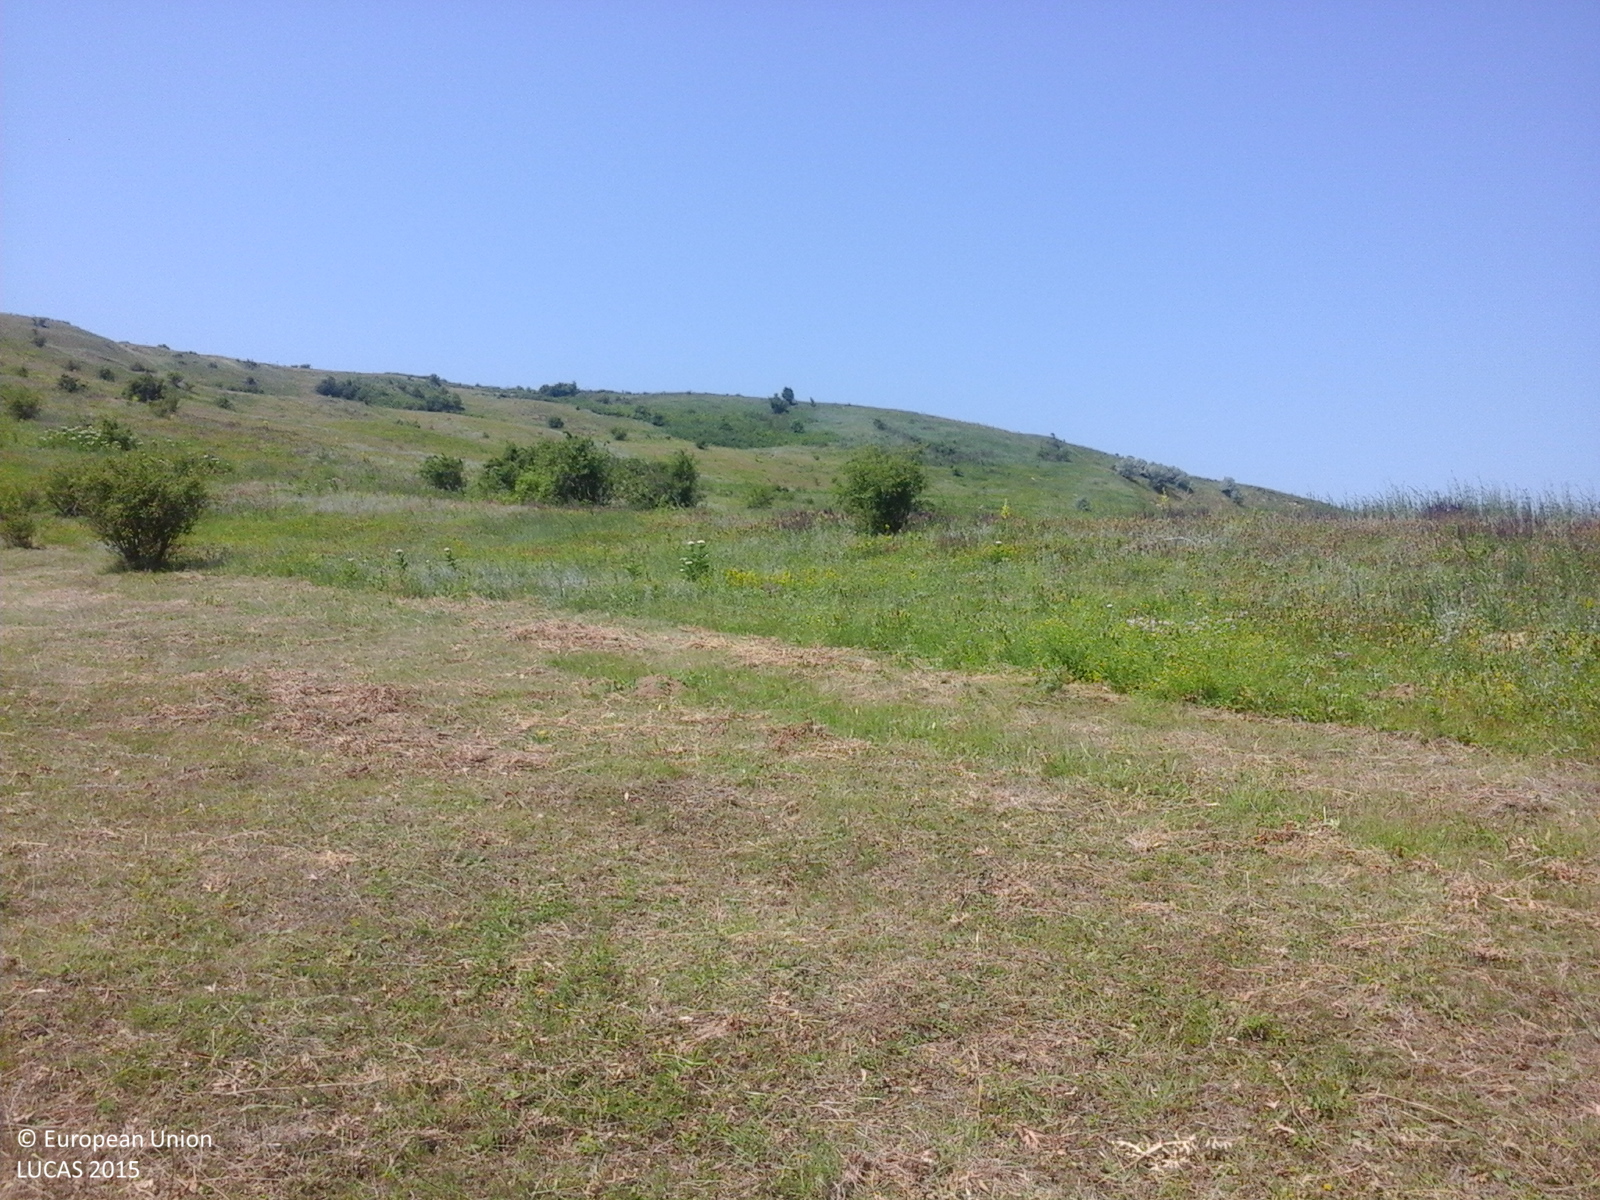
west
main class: Grassland
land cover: Grassland with sparse tree/shrub cover
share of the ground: > 75 %
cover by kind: herbaceous plants 90 %, broadleaved forest trees 5 %, shrubs 5 %
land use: Agriculture (excluding fallow land and kitchen gardens)
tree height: < 5 m
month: June
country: RO
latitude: 46.7429
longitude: 27.4536
